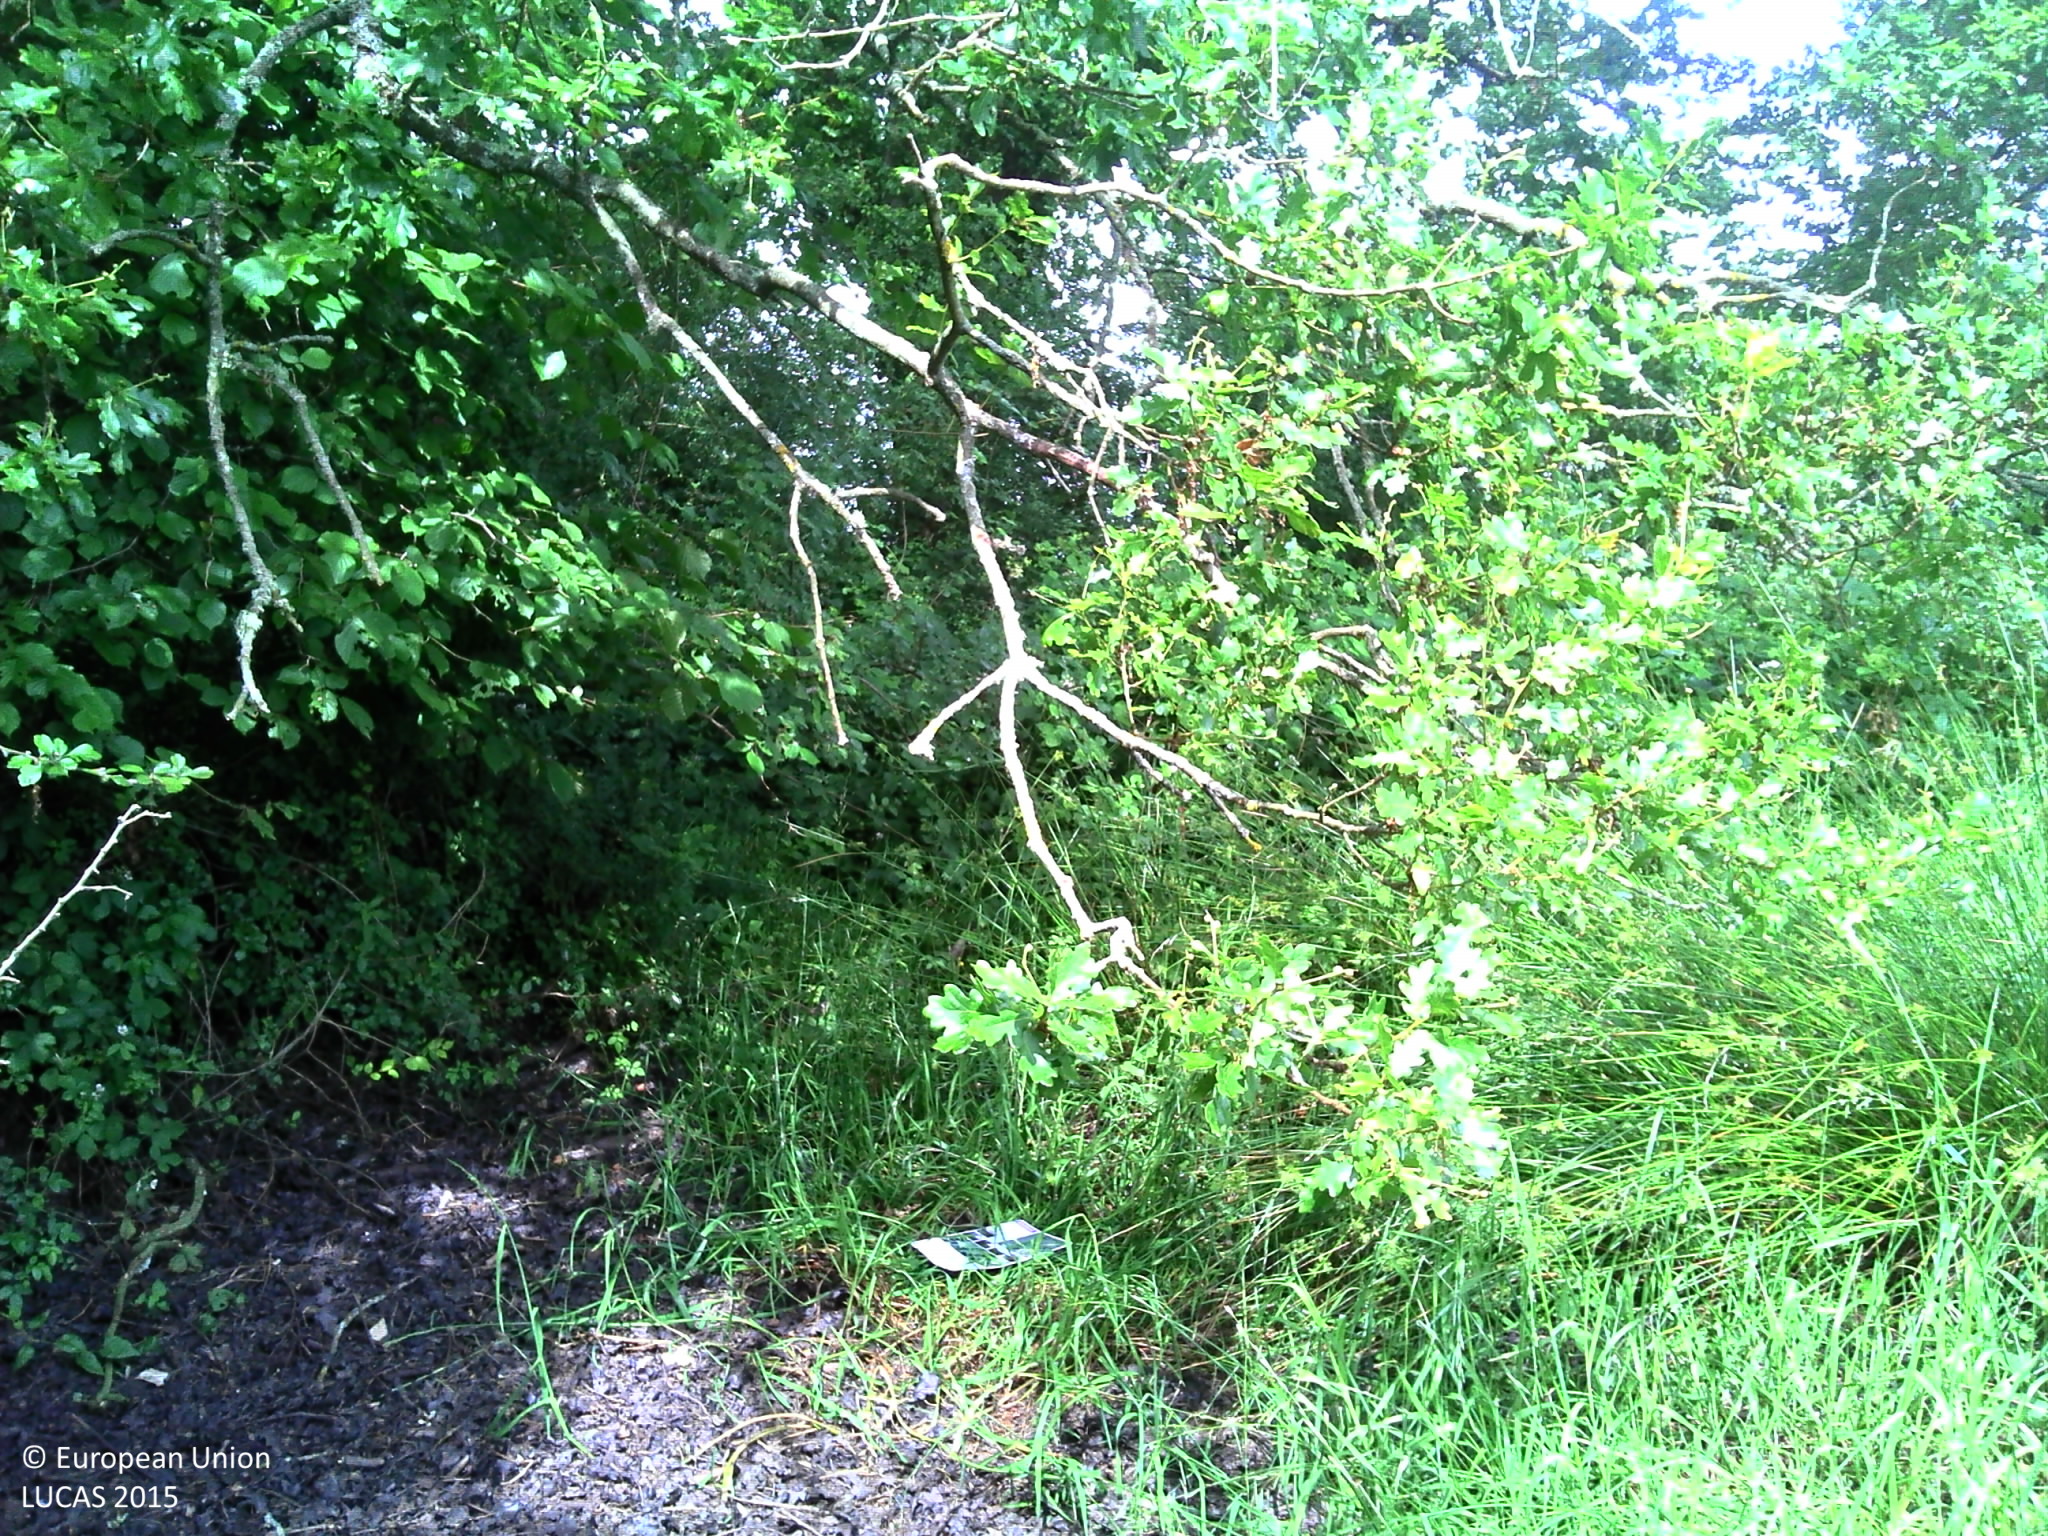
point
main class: Woodland
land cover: Broadleaved woodland
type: beech forest
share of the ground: > 75 %
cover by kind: broadleaved forest trees 75 %, herbaceous plants 15 %, shrubs 10 %
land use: Forestry
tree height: > 5 m
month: June
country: FR
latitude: 48.4383
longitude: 0.1995
